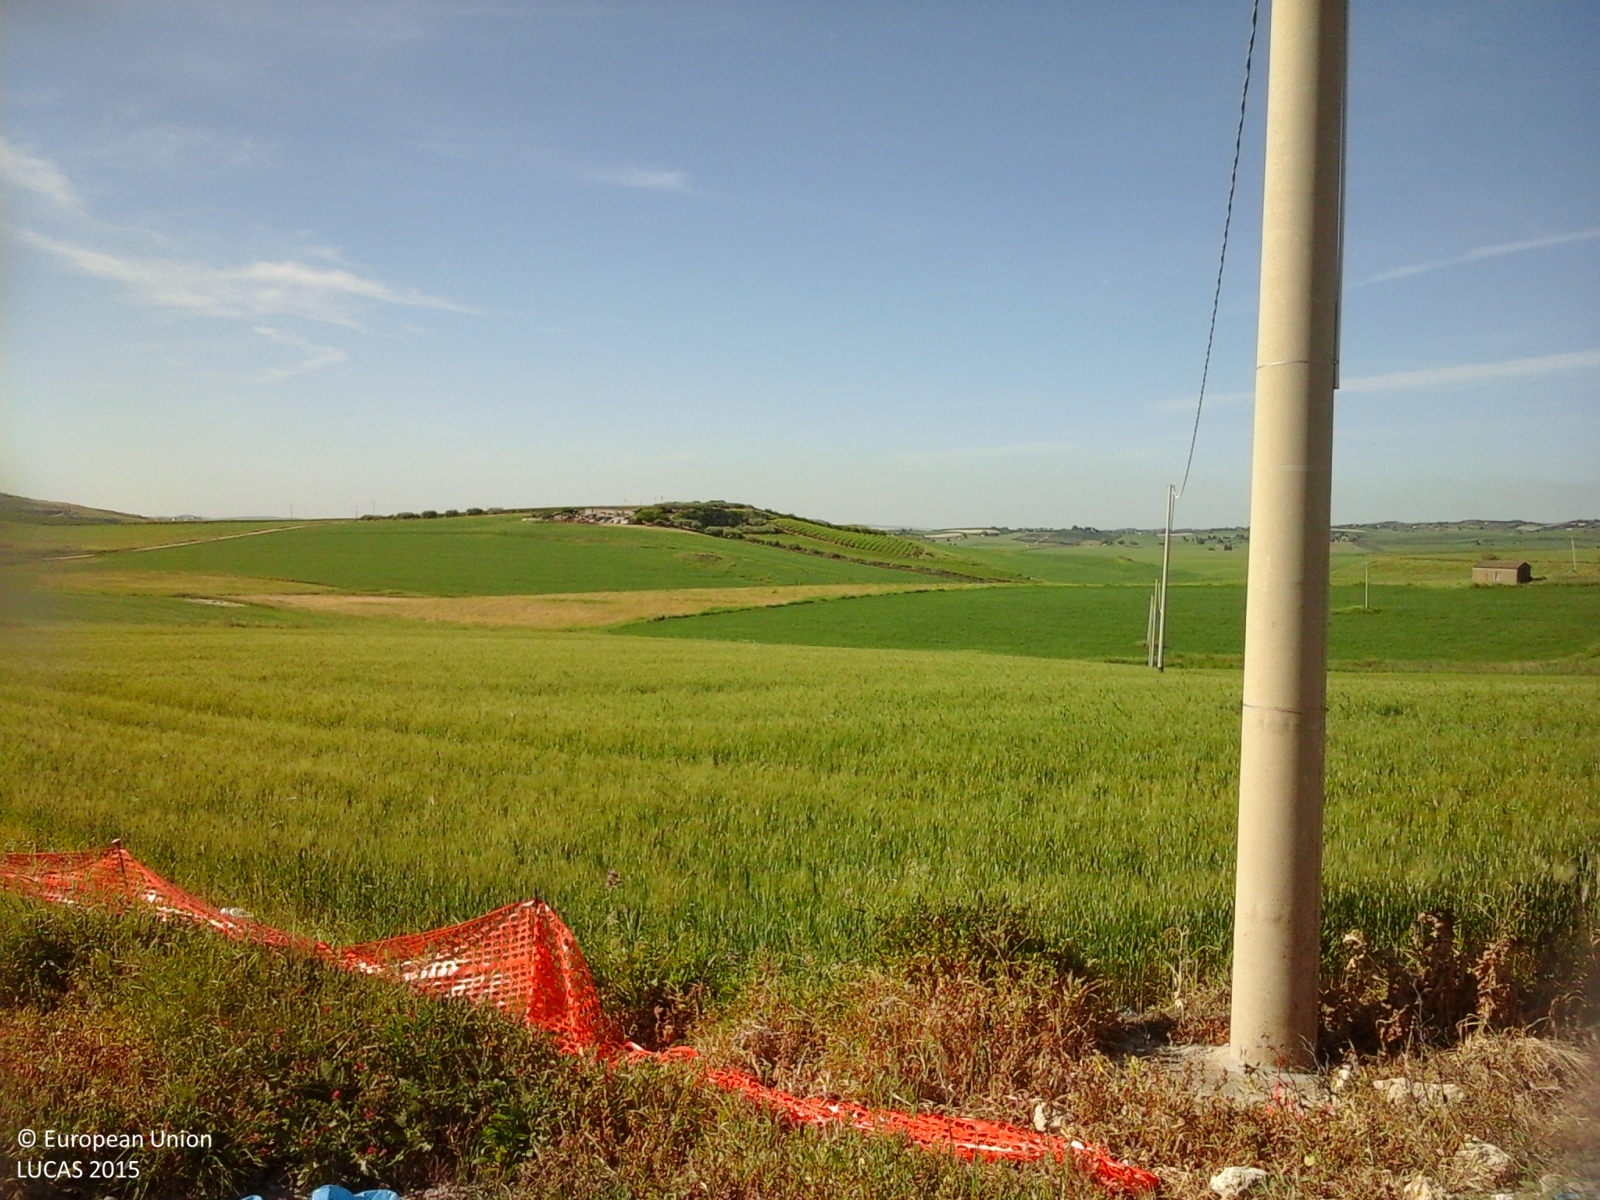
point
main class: Cropland
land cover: Vineyards
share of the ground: > 75 %
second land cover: Other bare soil
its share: > 75 %
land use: Agriculture (excluding fallow land and kitchen gardens)
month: May
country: IT
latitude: 37.4126
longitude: 13.9133
